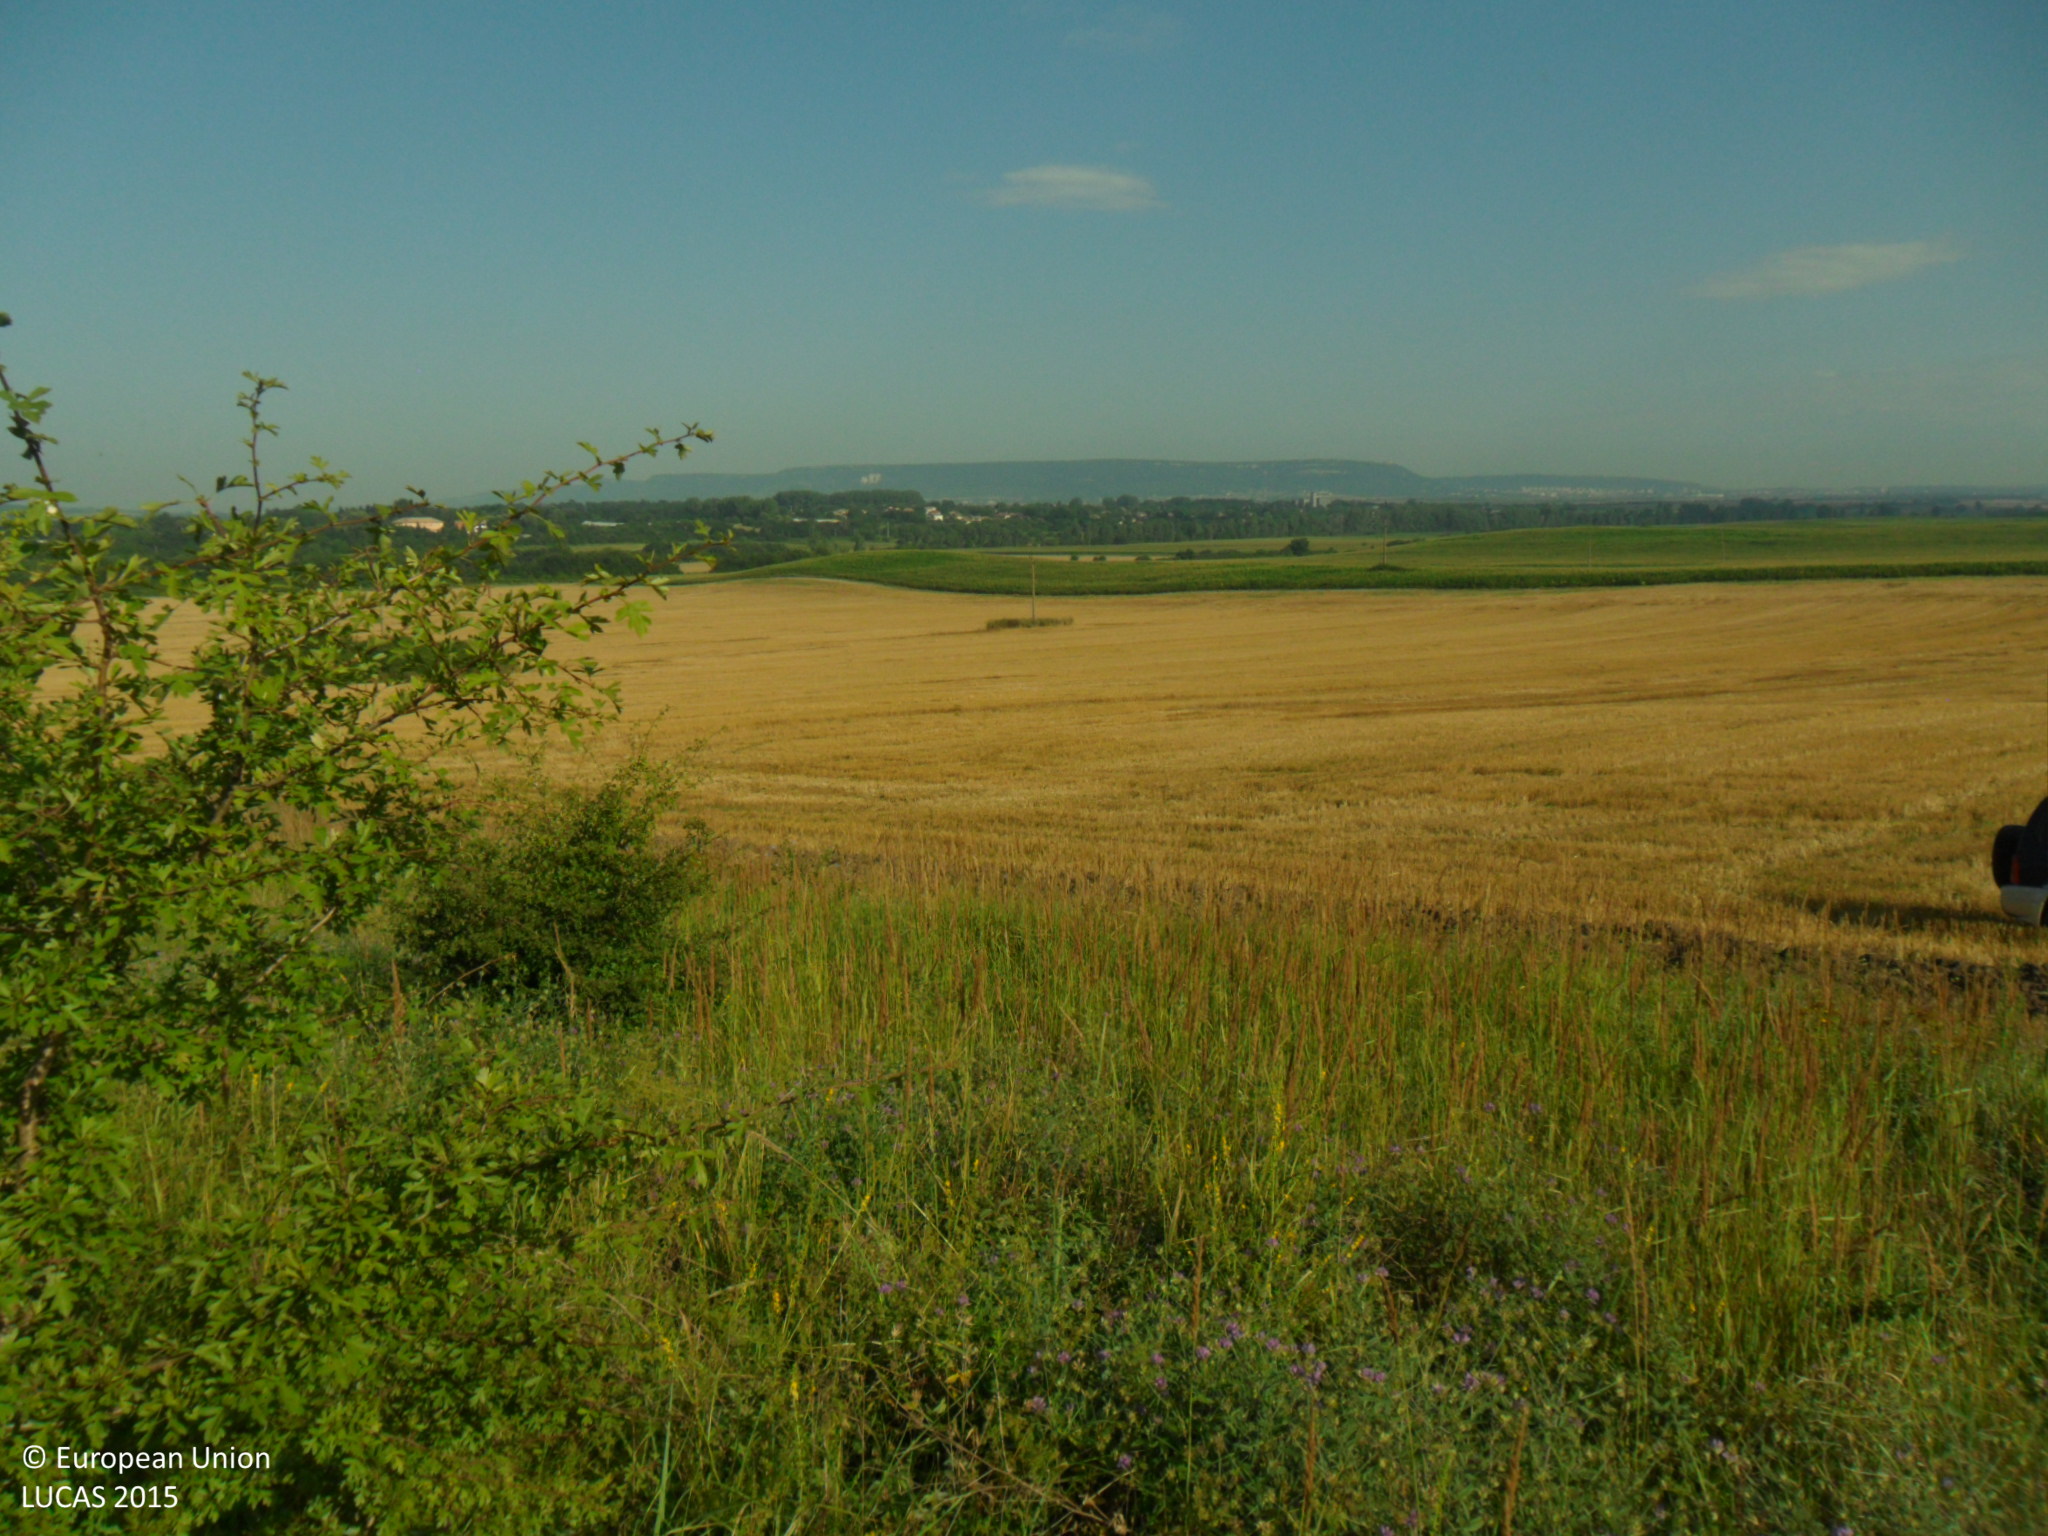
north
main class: Shrubland
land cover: Shrubland with sparse tree cover
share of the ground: > 75 %
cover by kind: shrubs 75 %, herbaceous plants 20 %, broadleaved forest trees 5 %
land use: Forestry
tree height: < 5 m
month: July
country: BG
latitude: 43.1698
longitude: 27.0275
